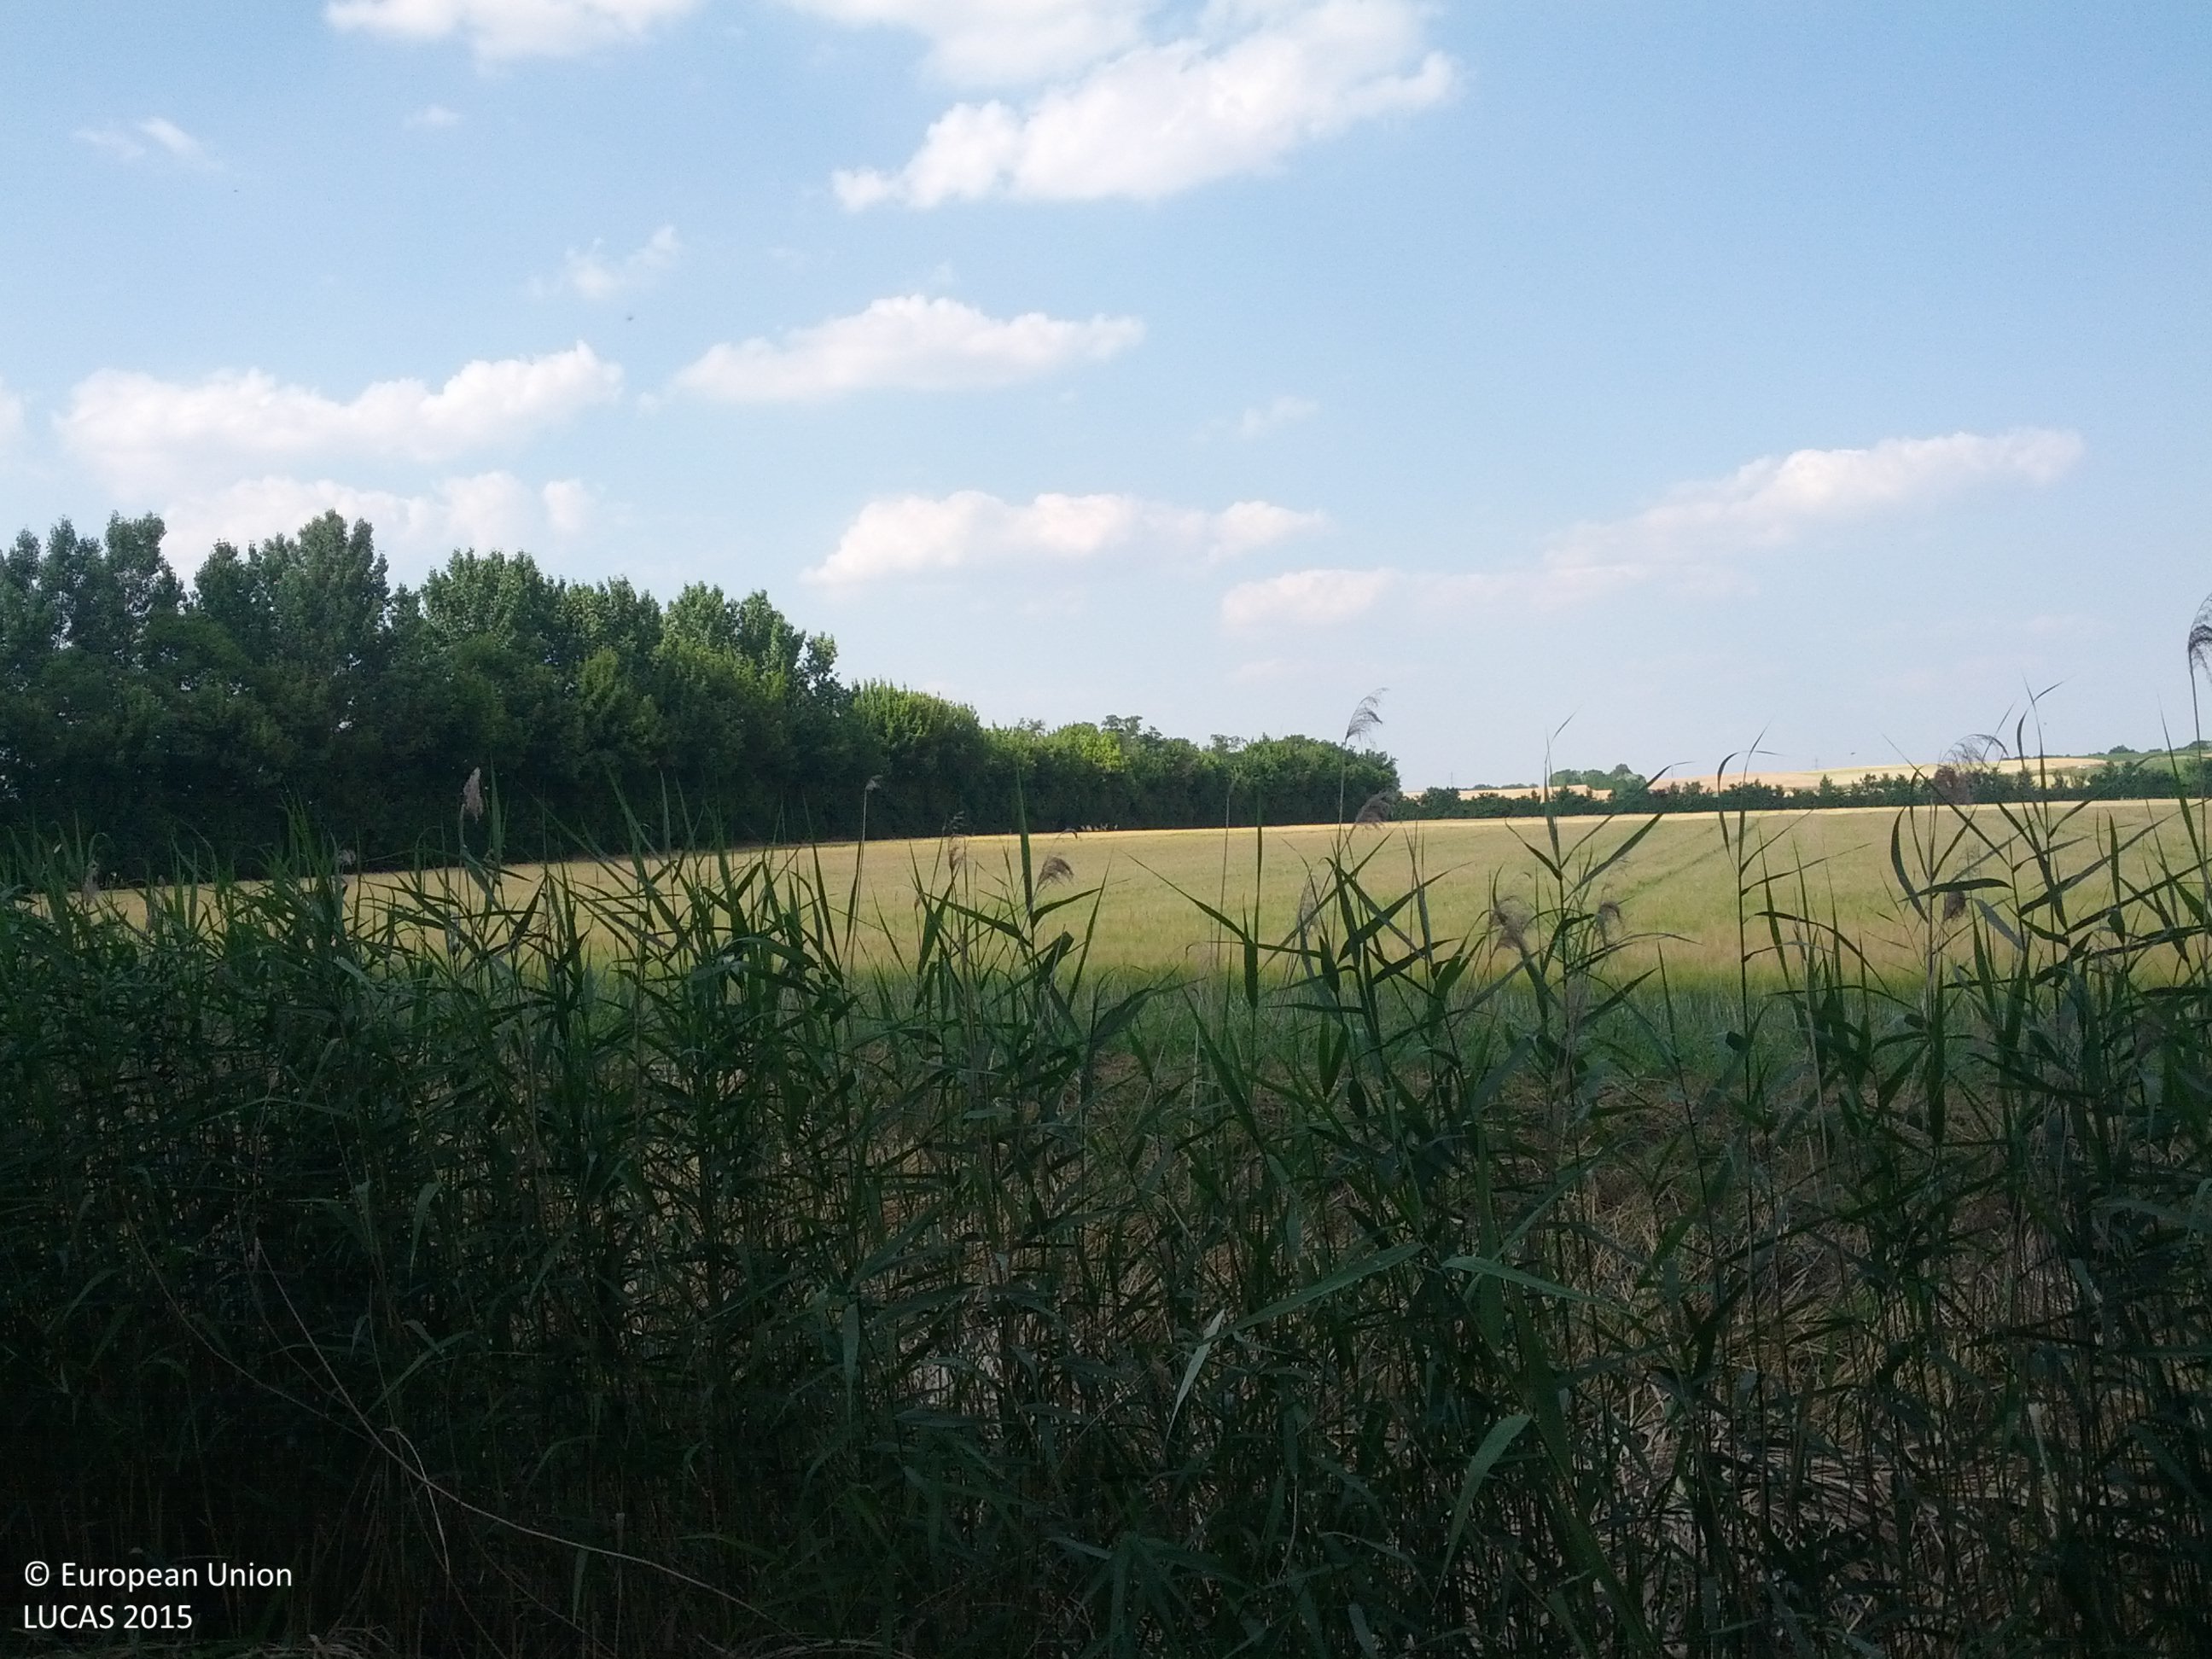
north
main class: Grassland
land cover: Grassland without tree/shrub cover
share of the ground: > 75 %
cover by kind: herbaceous plants 100 %
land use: Semi-natural and natural areas not in use
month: July
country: AT
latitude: 48.5896
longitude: 16.8270
